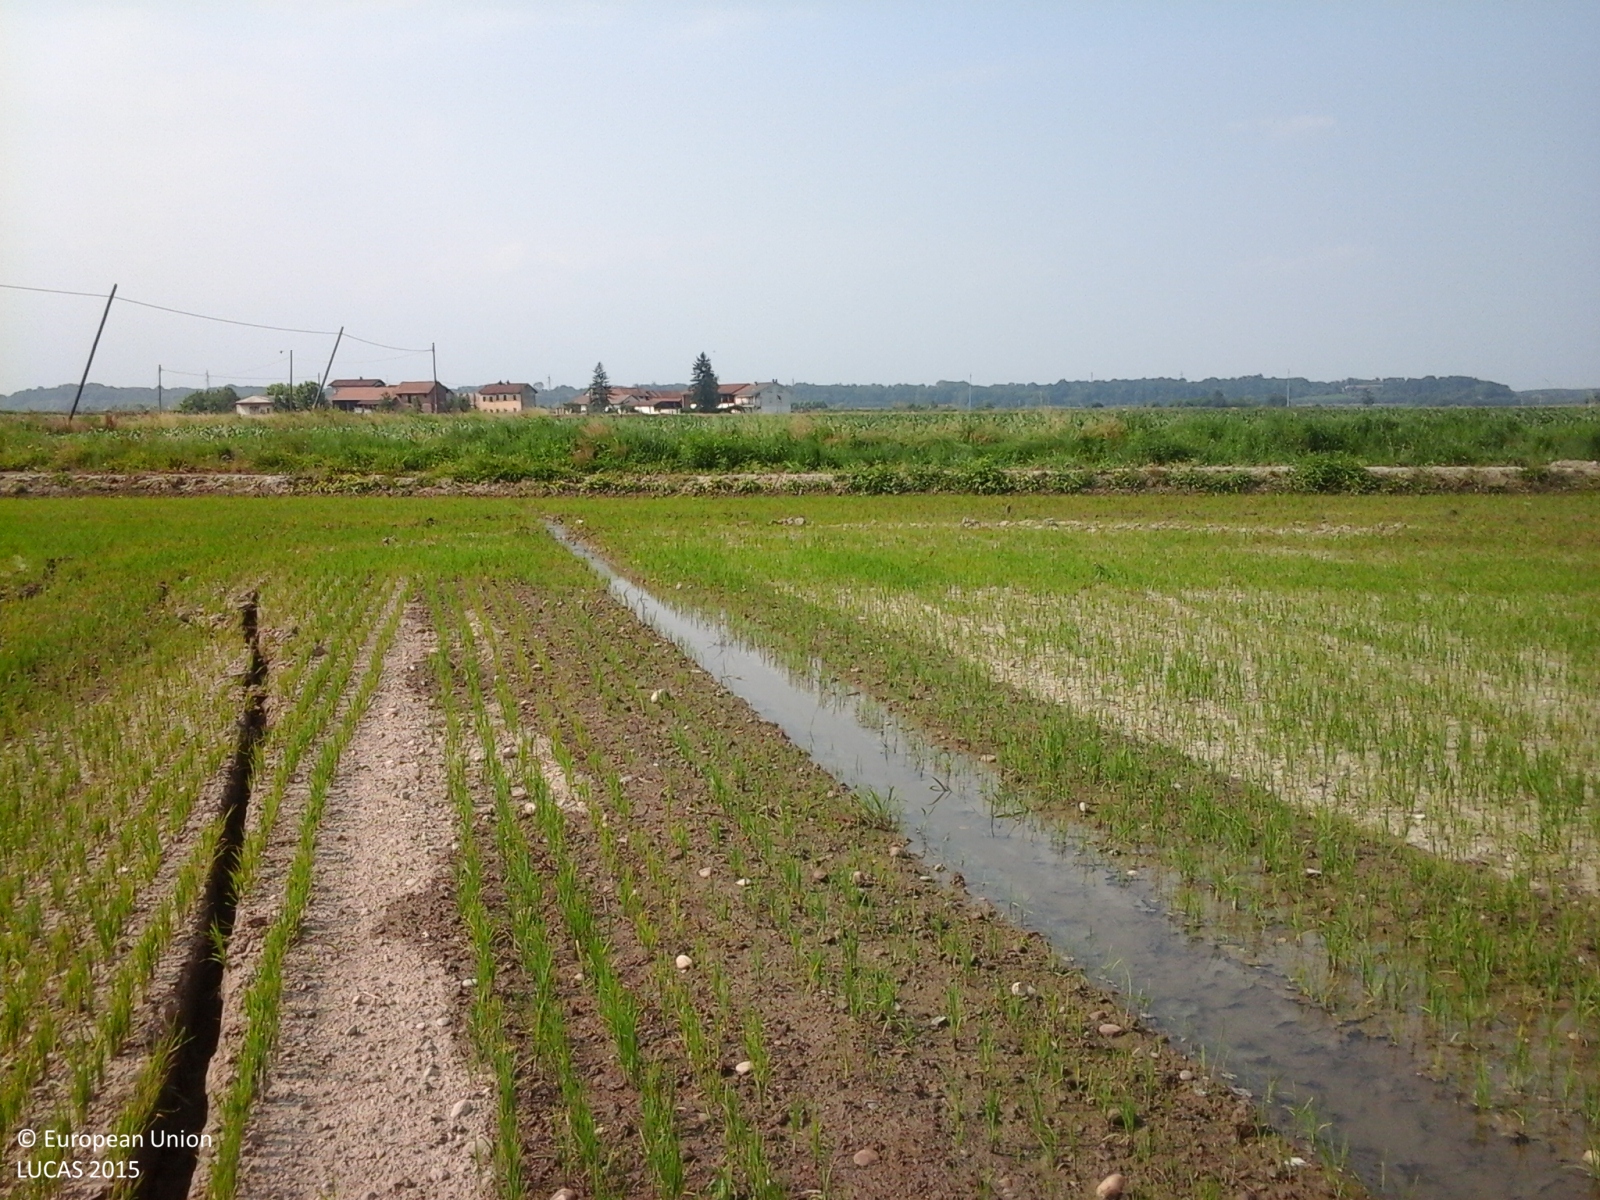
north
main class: Cropland
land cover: Rice
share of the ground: 25 - 50 %
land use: Agriculture (excluding fallow land and kitchen gardens)
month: May
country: IT
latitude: 45.3809
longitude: 8.2023
